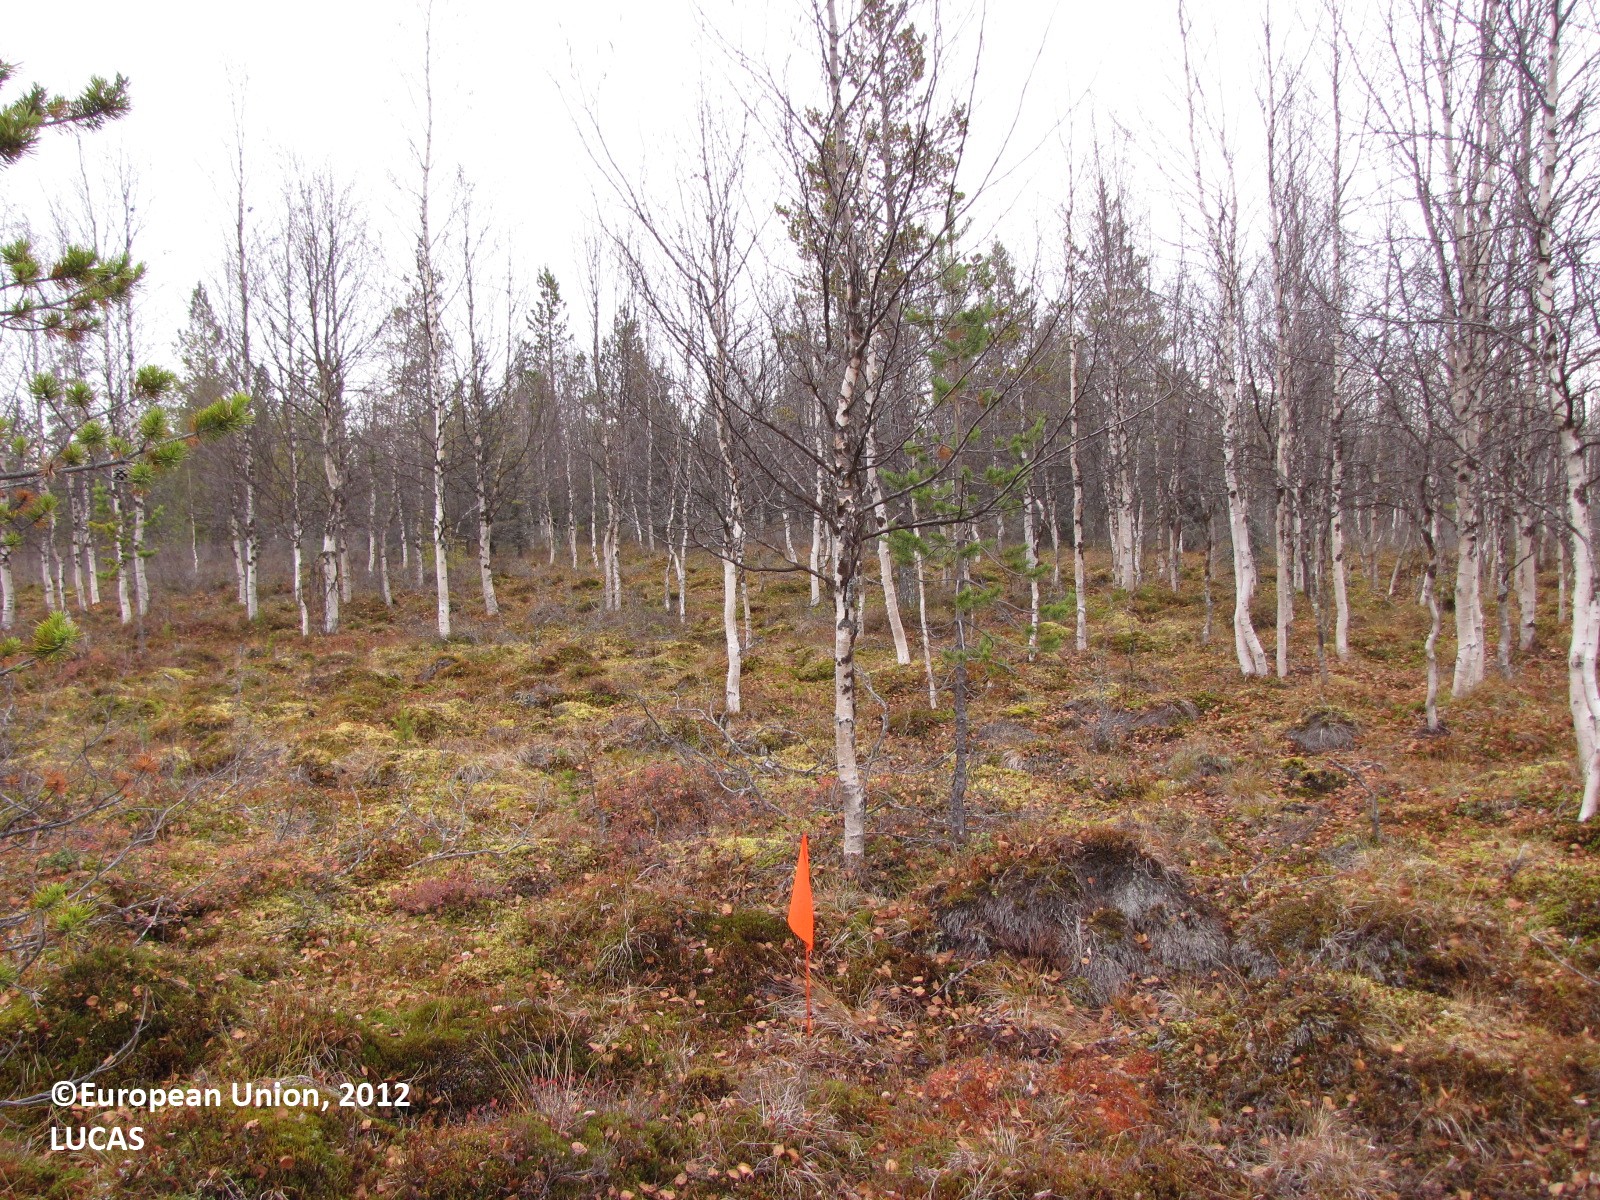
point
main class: Woodland
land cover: Pine dominated mixed woodland
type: boreal forest
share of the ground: 25 - 50 %
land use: Forestry
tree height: > 5 m
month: September
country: FI
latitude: 67.6751
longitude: 24.1055
